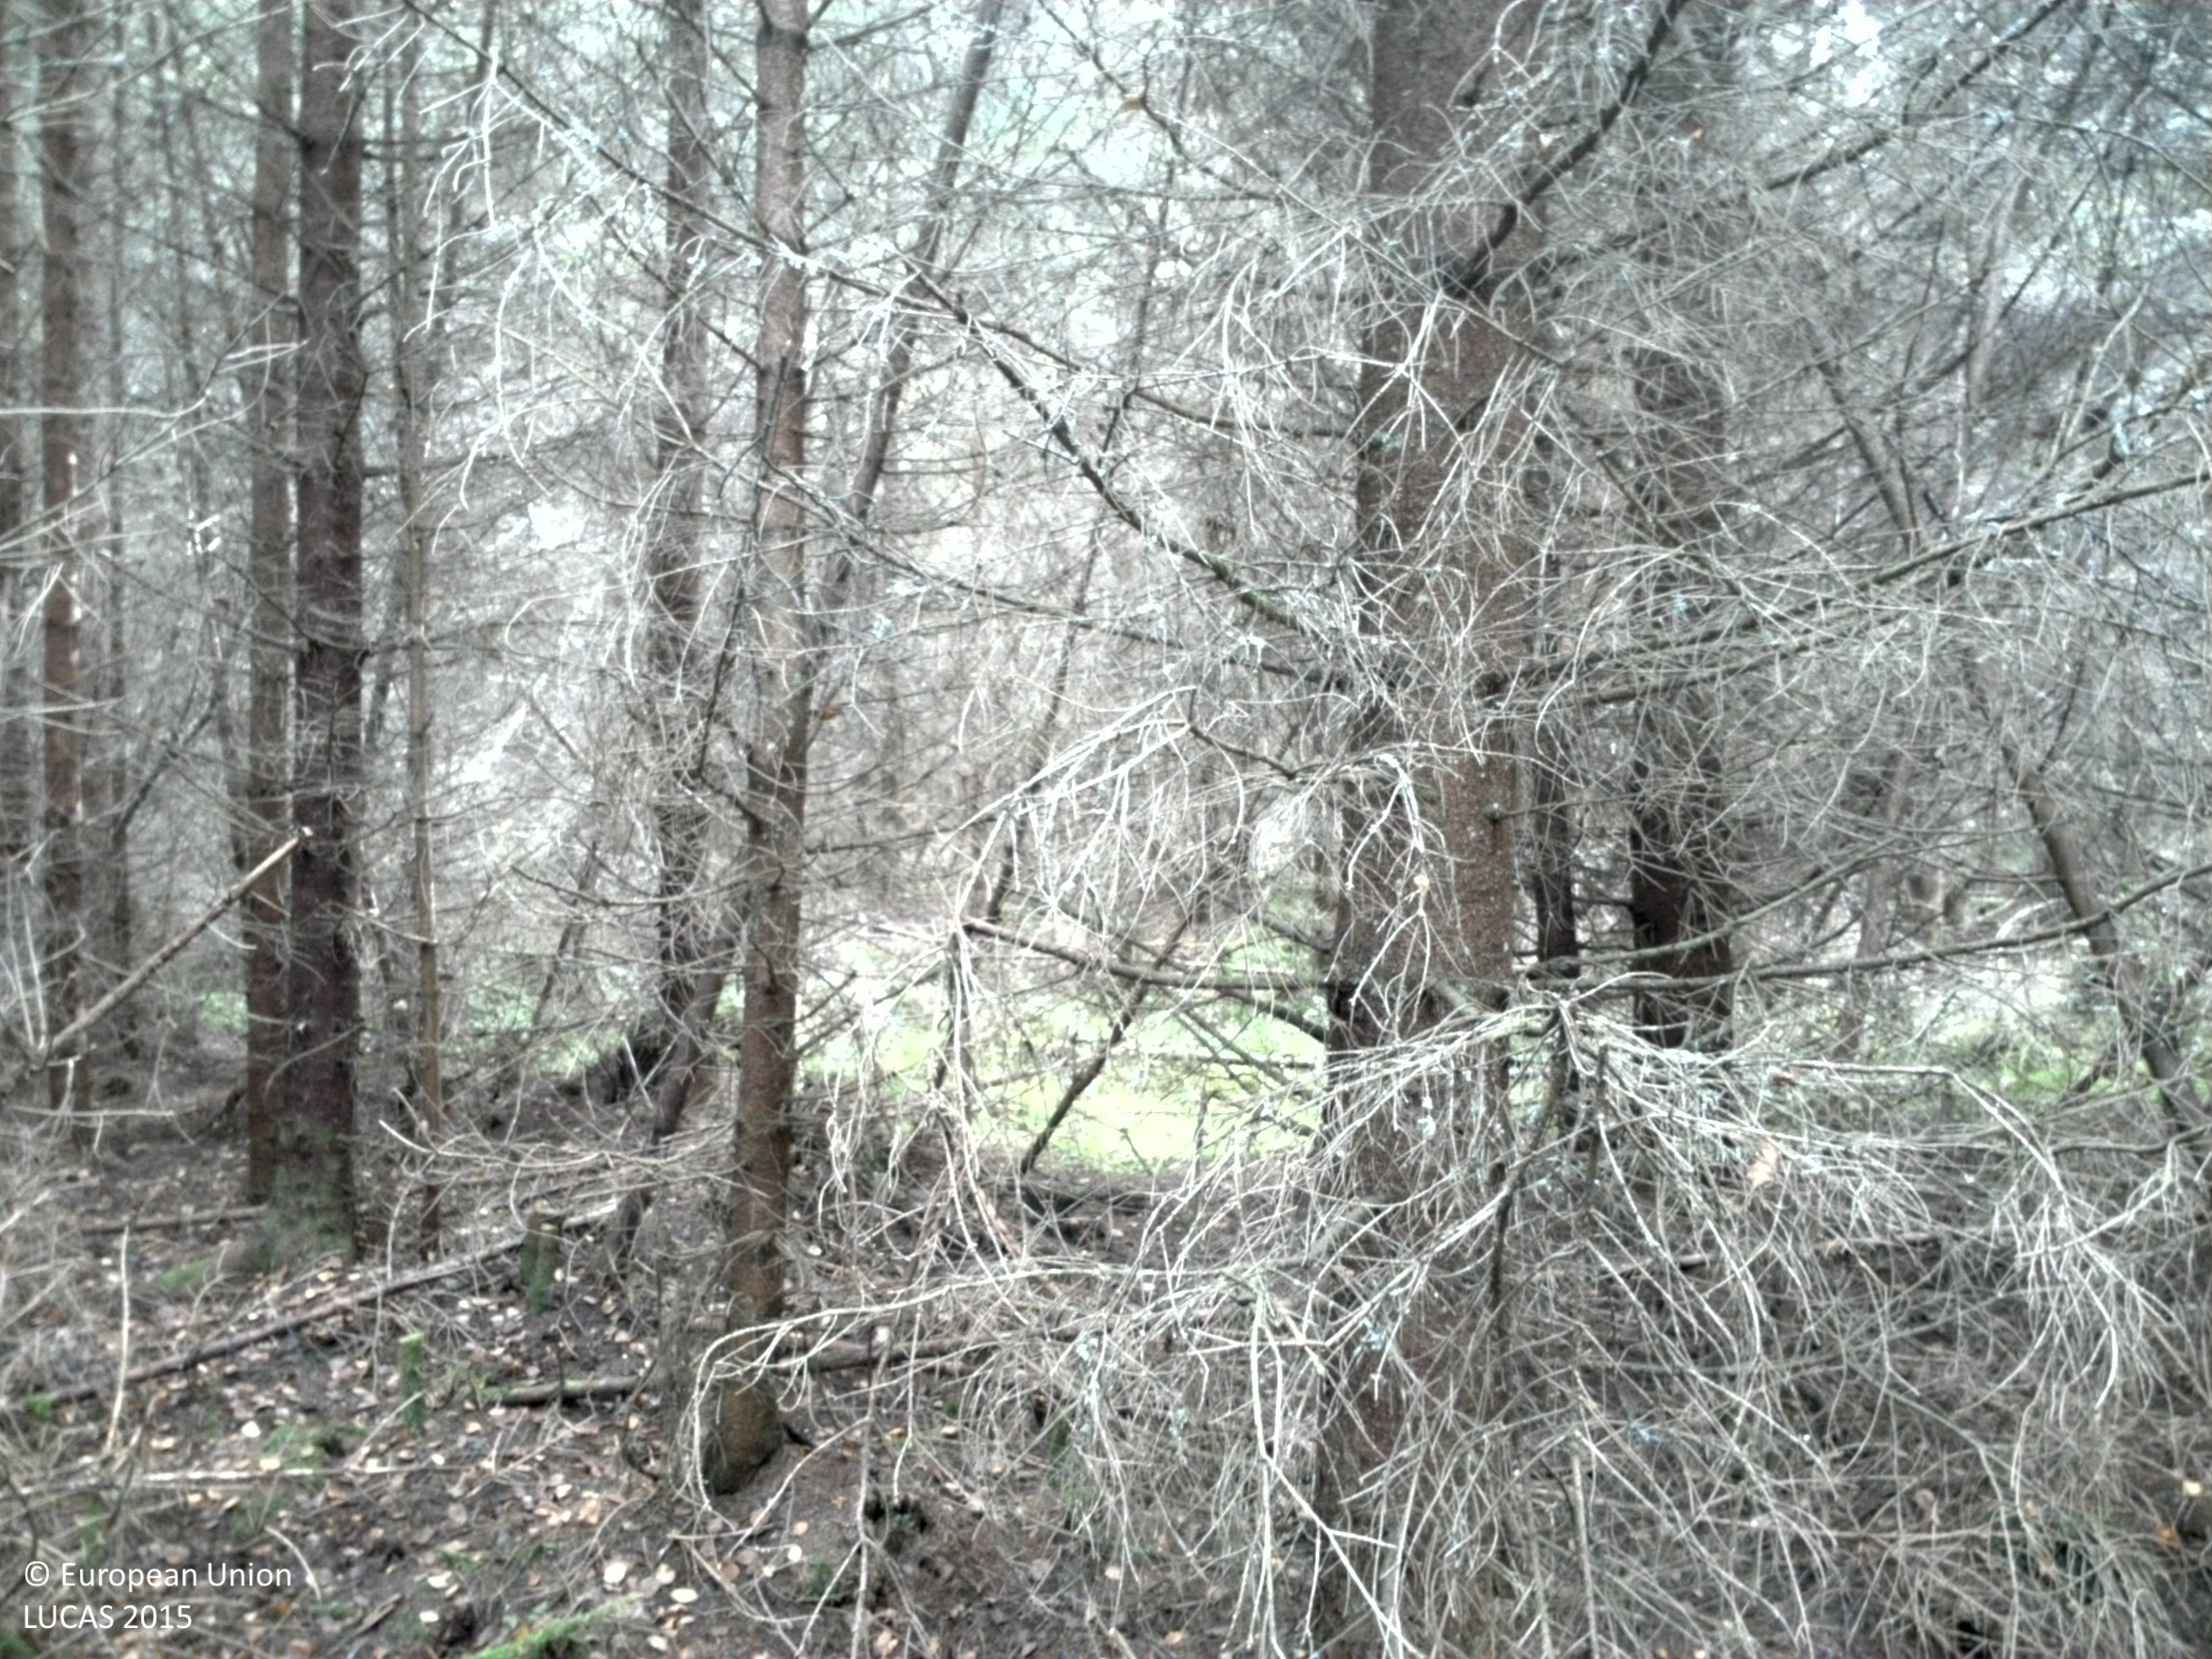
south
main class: Woodland
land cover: Spruce dominated coniferous woodland
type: boreal forest
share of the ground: 50 - 75 %
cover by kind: coniferous forest trees 60 %, lichens and mosses 35 %, broadleaved forest trees 5 %
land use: Forestry
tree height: > 5 m
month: September
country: SE
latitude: 59.1288
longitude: 14.1331
